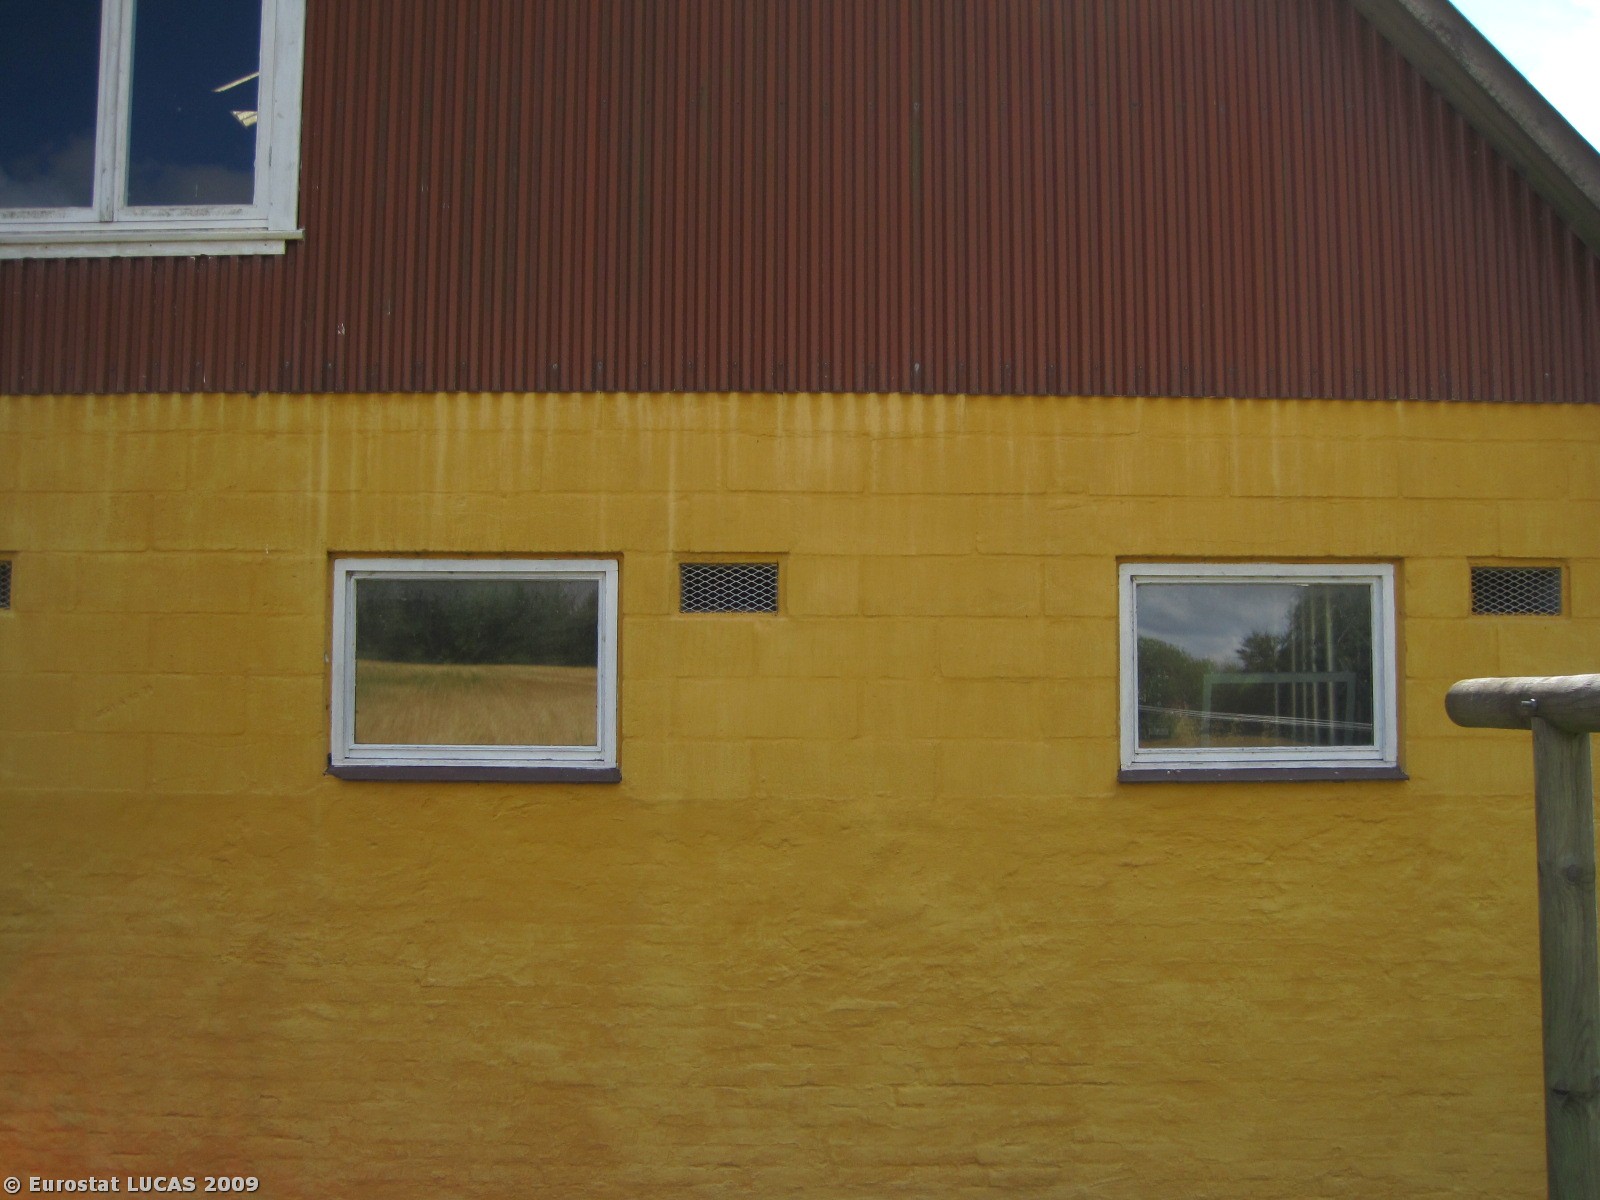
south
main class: Cropland
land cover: Barley
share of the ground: > 75 %
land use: Agriculture (excluding fallow land and kitchen gardens)
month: July
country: DK
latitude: 56.9726
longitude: 8.7351
